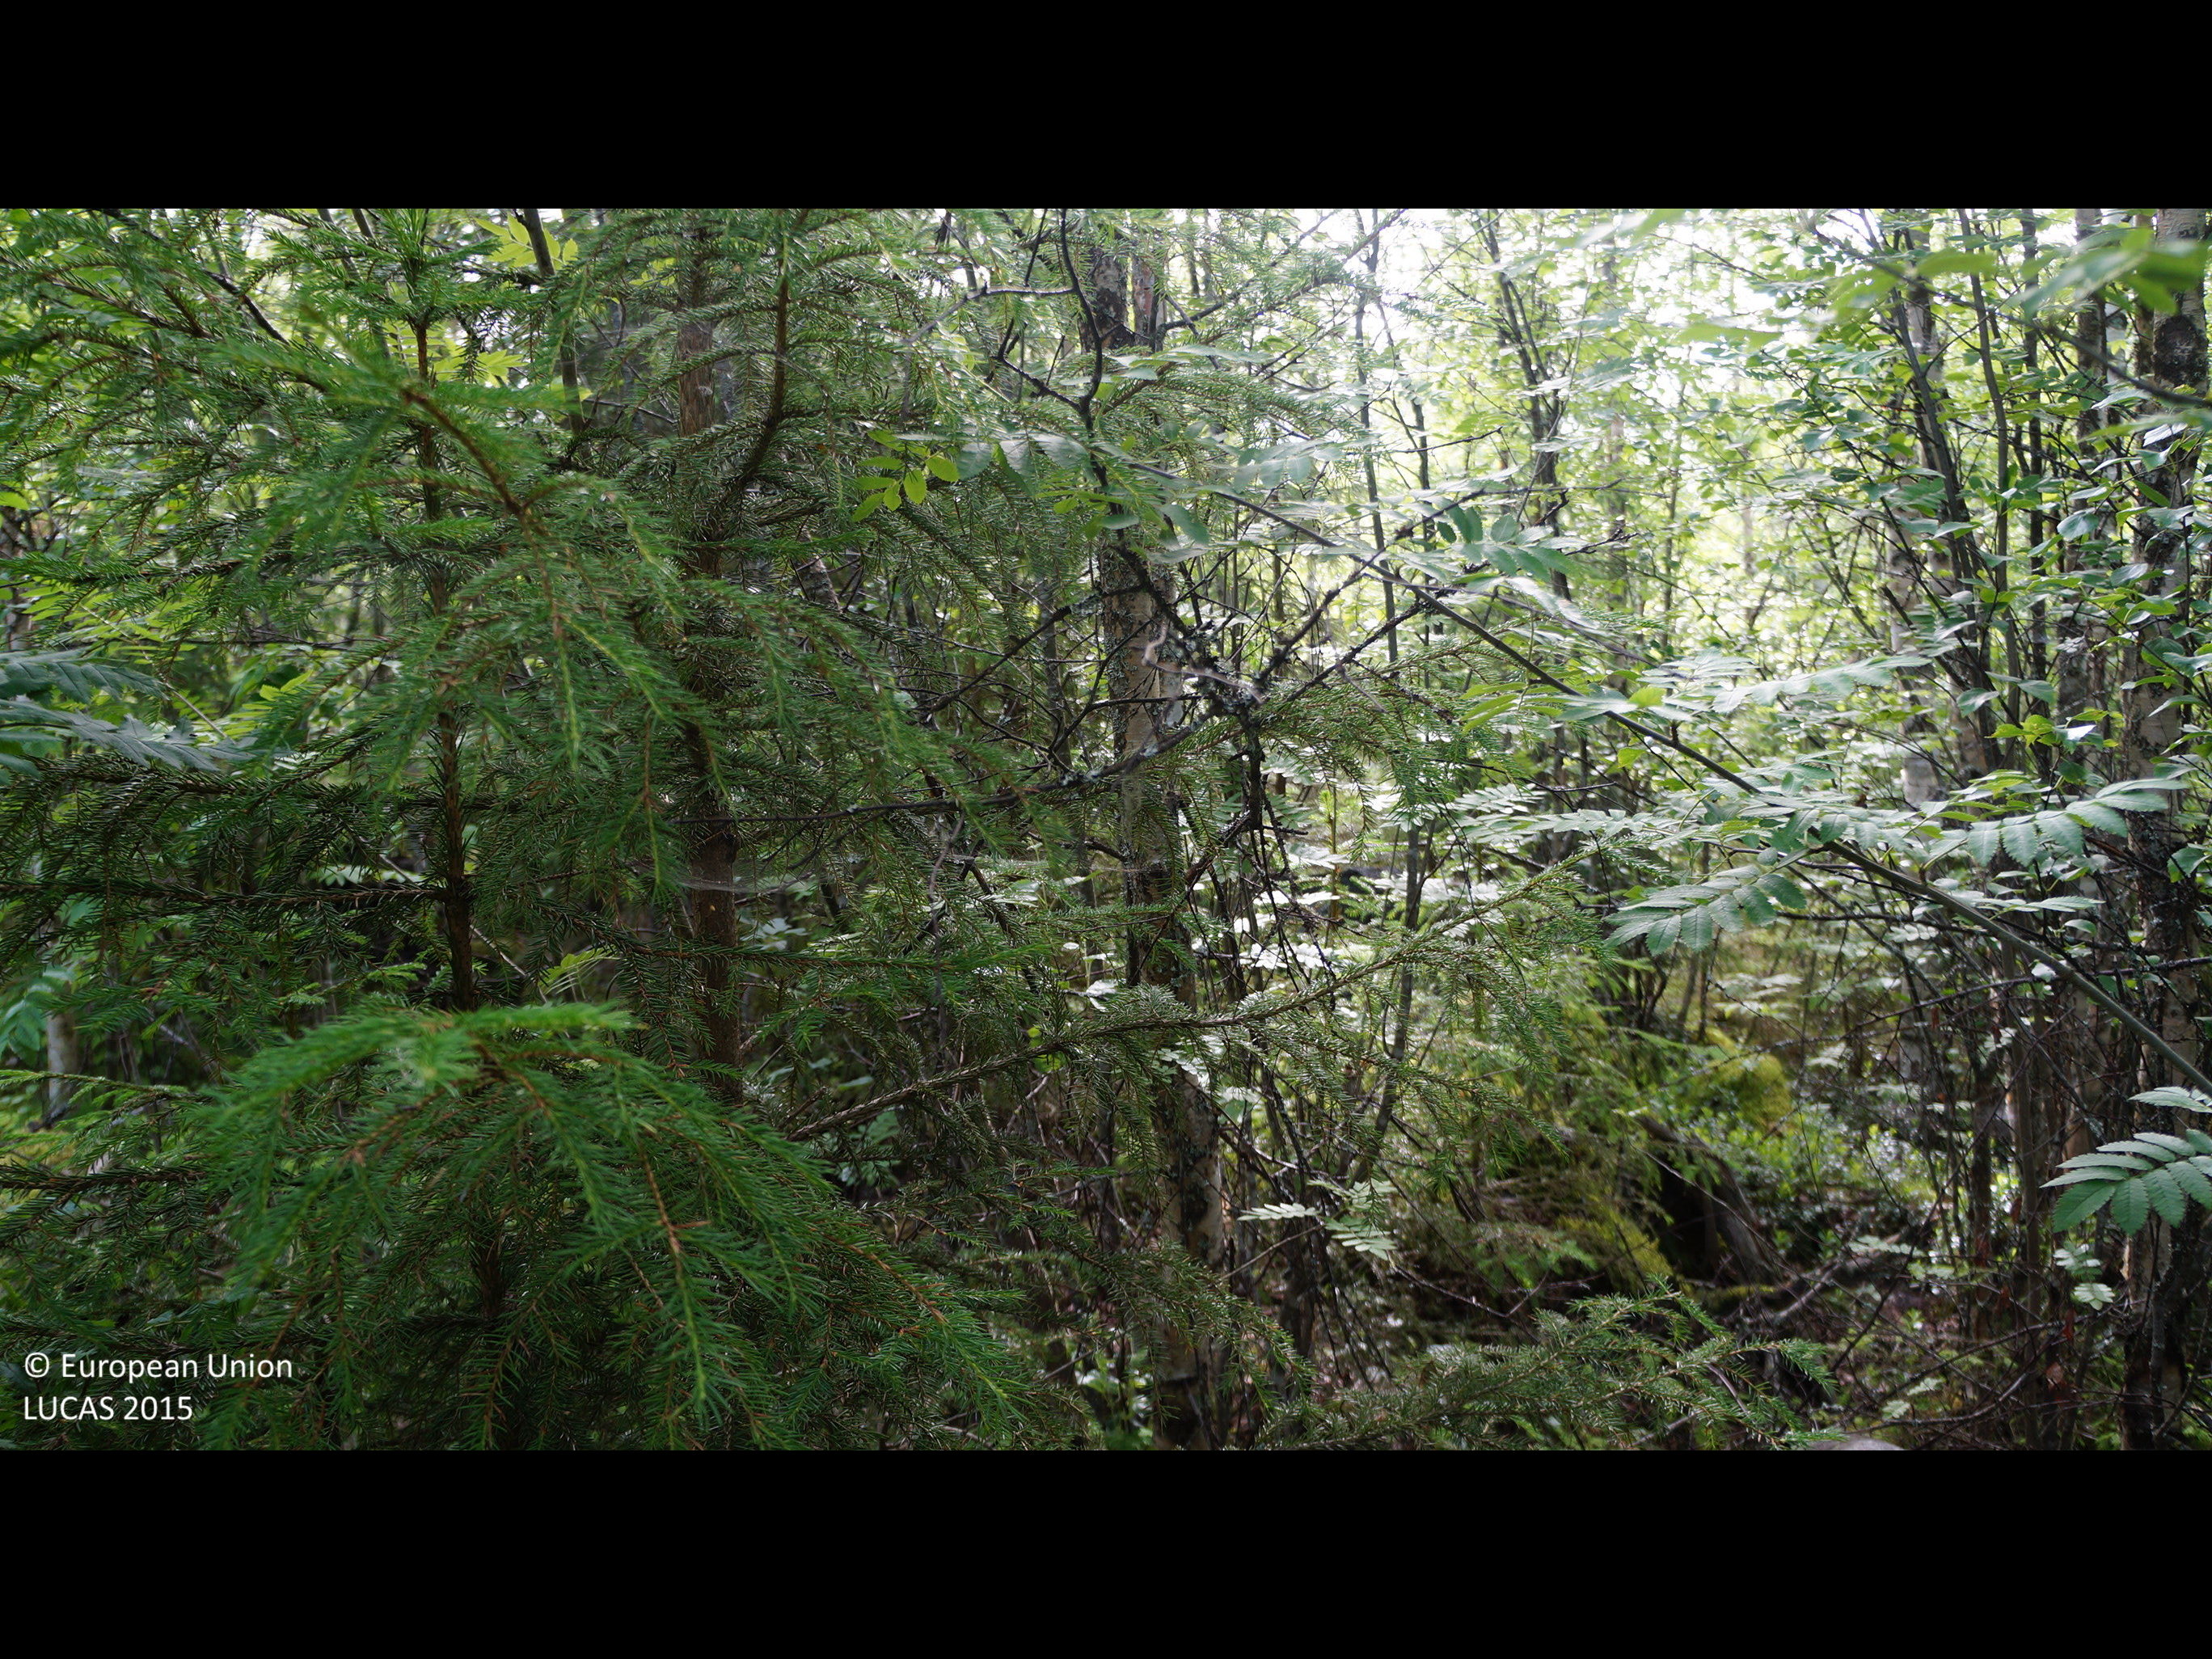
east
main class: Woodland
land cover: Broadleaved woodland
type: boreal forest
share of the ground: > 75 %
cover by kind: broadleaved forest trees 65 %, coniferous forest trees 15 %, shrubs 10 %, herbaceous plants 10 %
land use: Forestry
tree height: > 5 m
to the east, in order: Broadleaved woodland; Ditches and canals; Broadleaved woodland; Tracks; Shrubland with sparse tree cover; Tracks; Broadleaved woodland; Pine dominated coniferous woodland; Broadleaved woodland; Spruce dominated mixed woodland; Ditches and canals; Abandoned hedges; Tracks; Broadleaved woodland; Pine dominated coniferous woodland
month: July
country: FI
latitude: 64.3185
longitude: 24.4859
